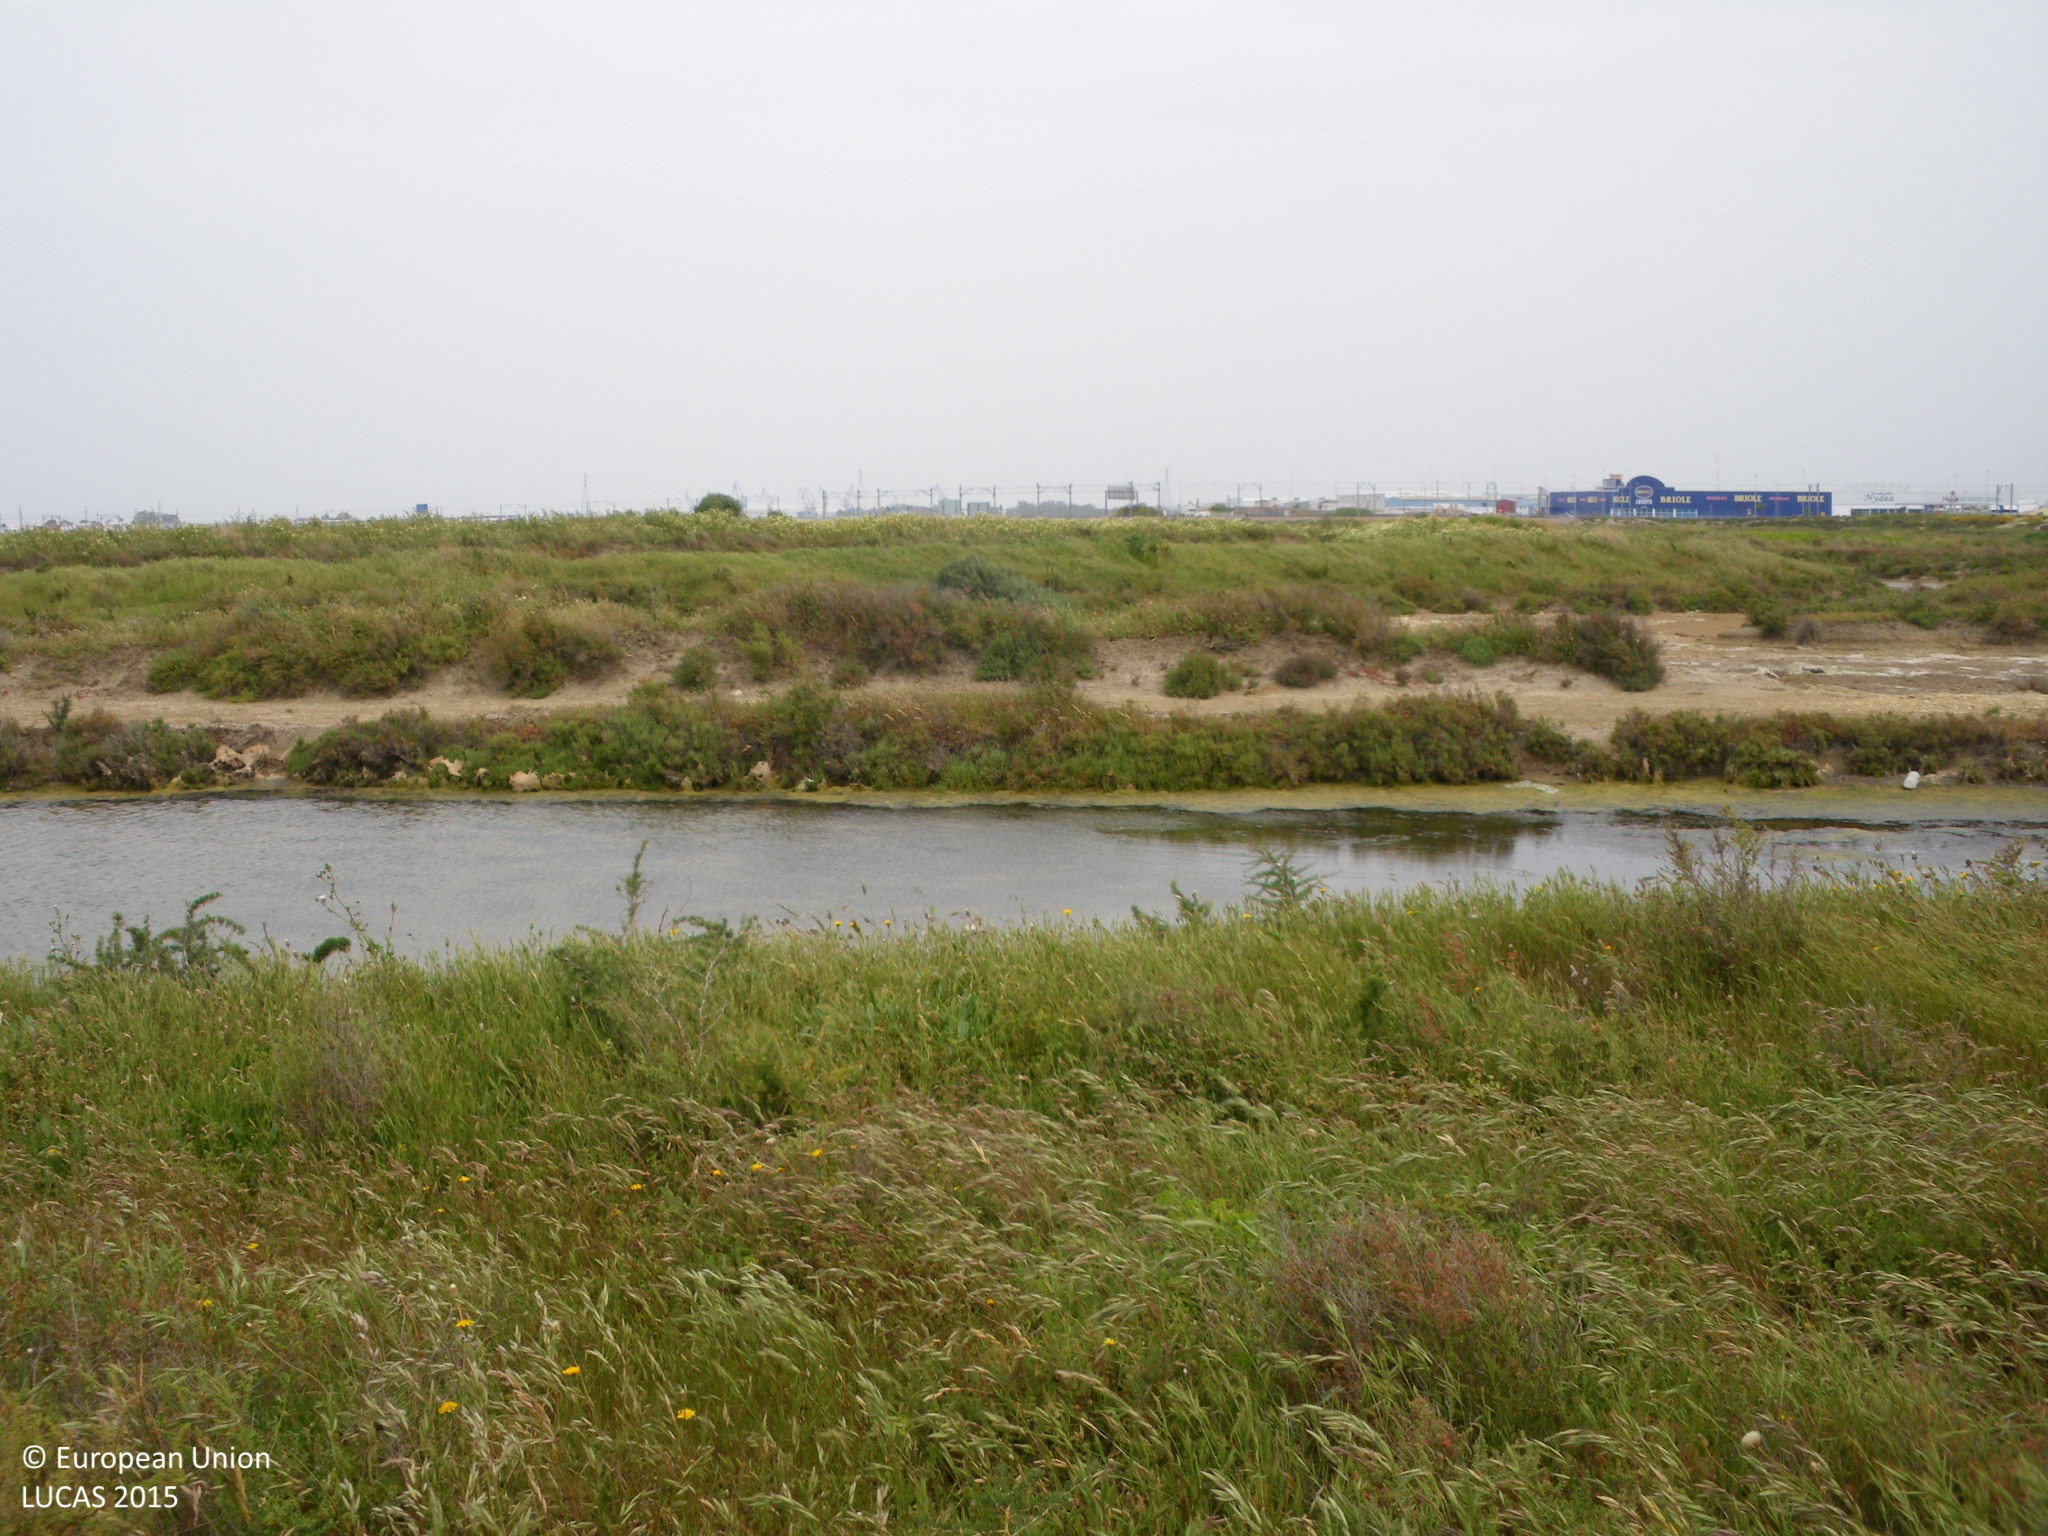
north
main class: Shrubland
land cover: Shrubland without tree cover
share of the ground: 25 - 50 %
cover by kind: herbaceous plants 50 %, shrubs 40 %, unconsolidated bare surface 10 %
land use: Semi-natural and natural areas not in use
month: April
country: ES
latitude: 36.4631
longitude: -6.1778
